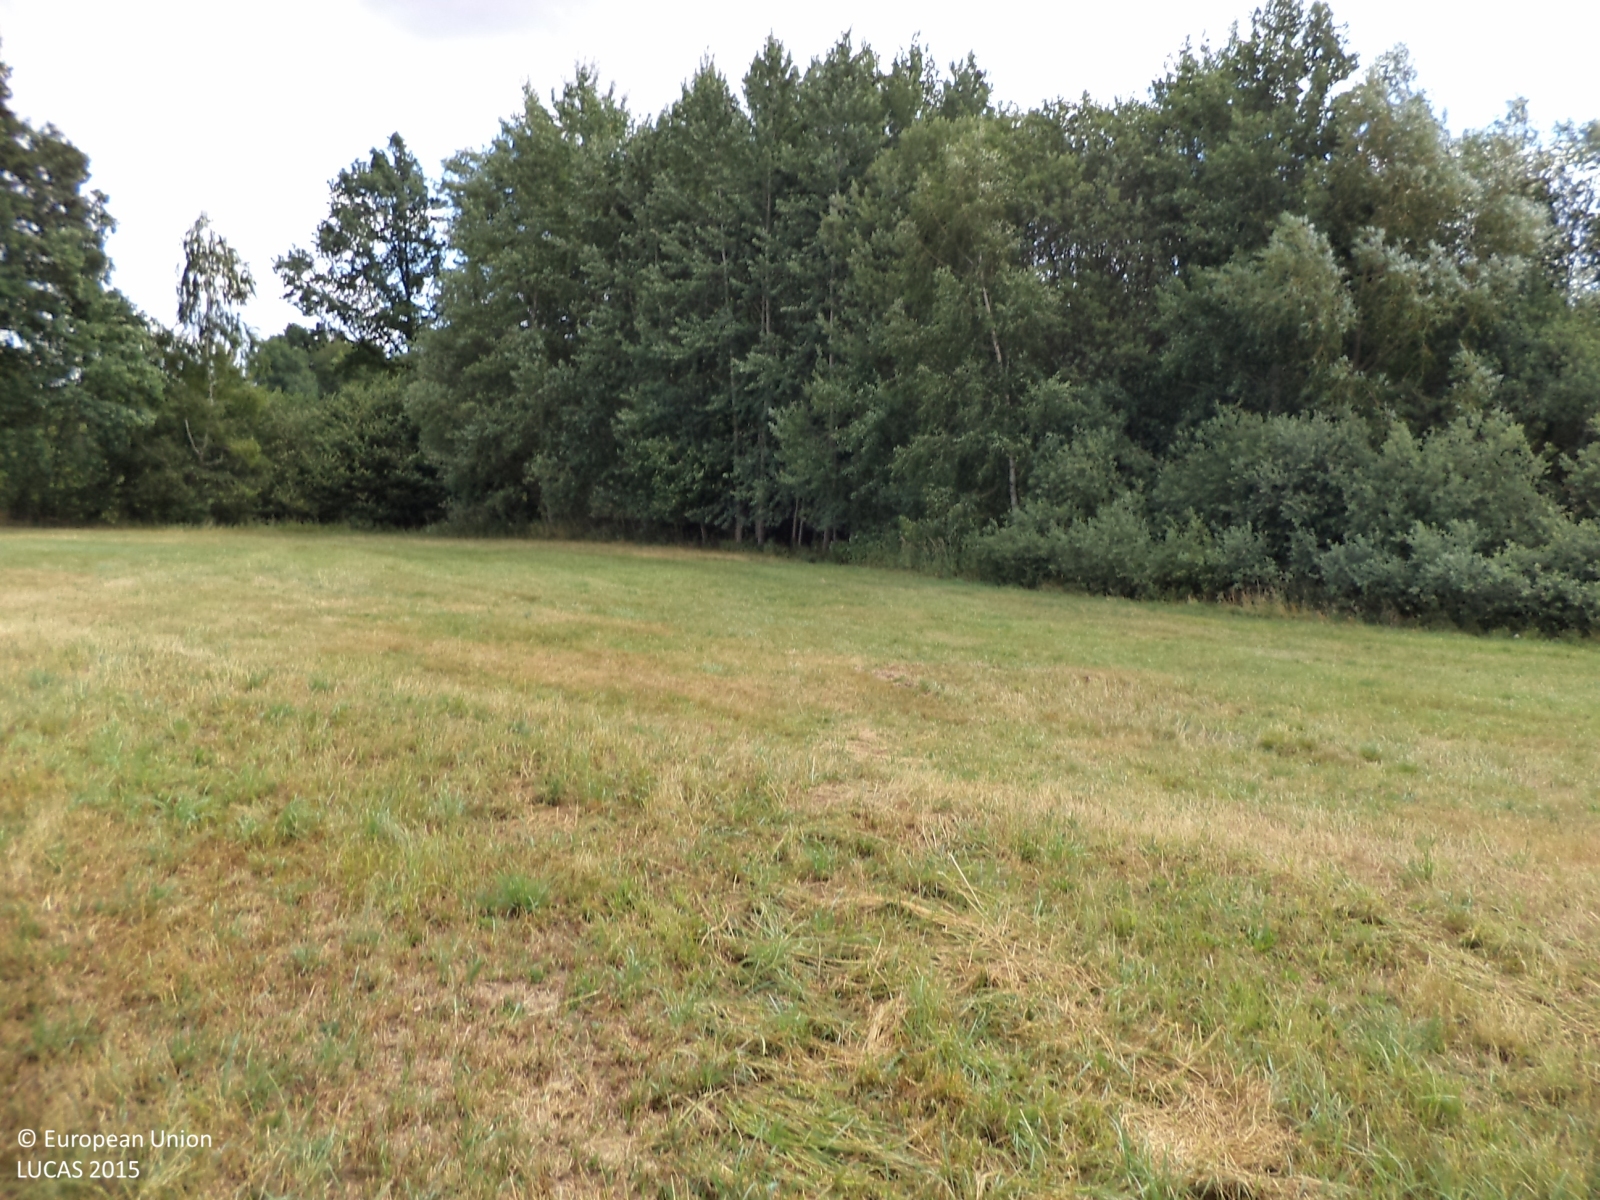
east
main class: Grassland
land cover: Grassland without tree/shrub cover
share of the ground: > 75 %
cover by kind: herbaceous plants 100 %
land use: Agriculture (excluding fallow land and kitchen gardens)
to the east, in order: Grassland without tree/shrub cover; Broadleaved woodland; Tracks; Broadleaved woodland; Spruce dominated coniferous woodland; Spruce dominated mixed woodland; Ditches and canals; Spruce dominated mixed woodland; Tracks; Spruce dominated mixed woodland
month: July
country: CZ
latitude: 49.6821
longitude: 14.4782
